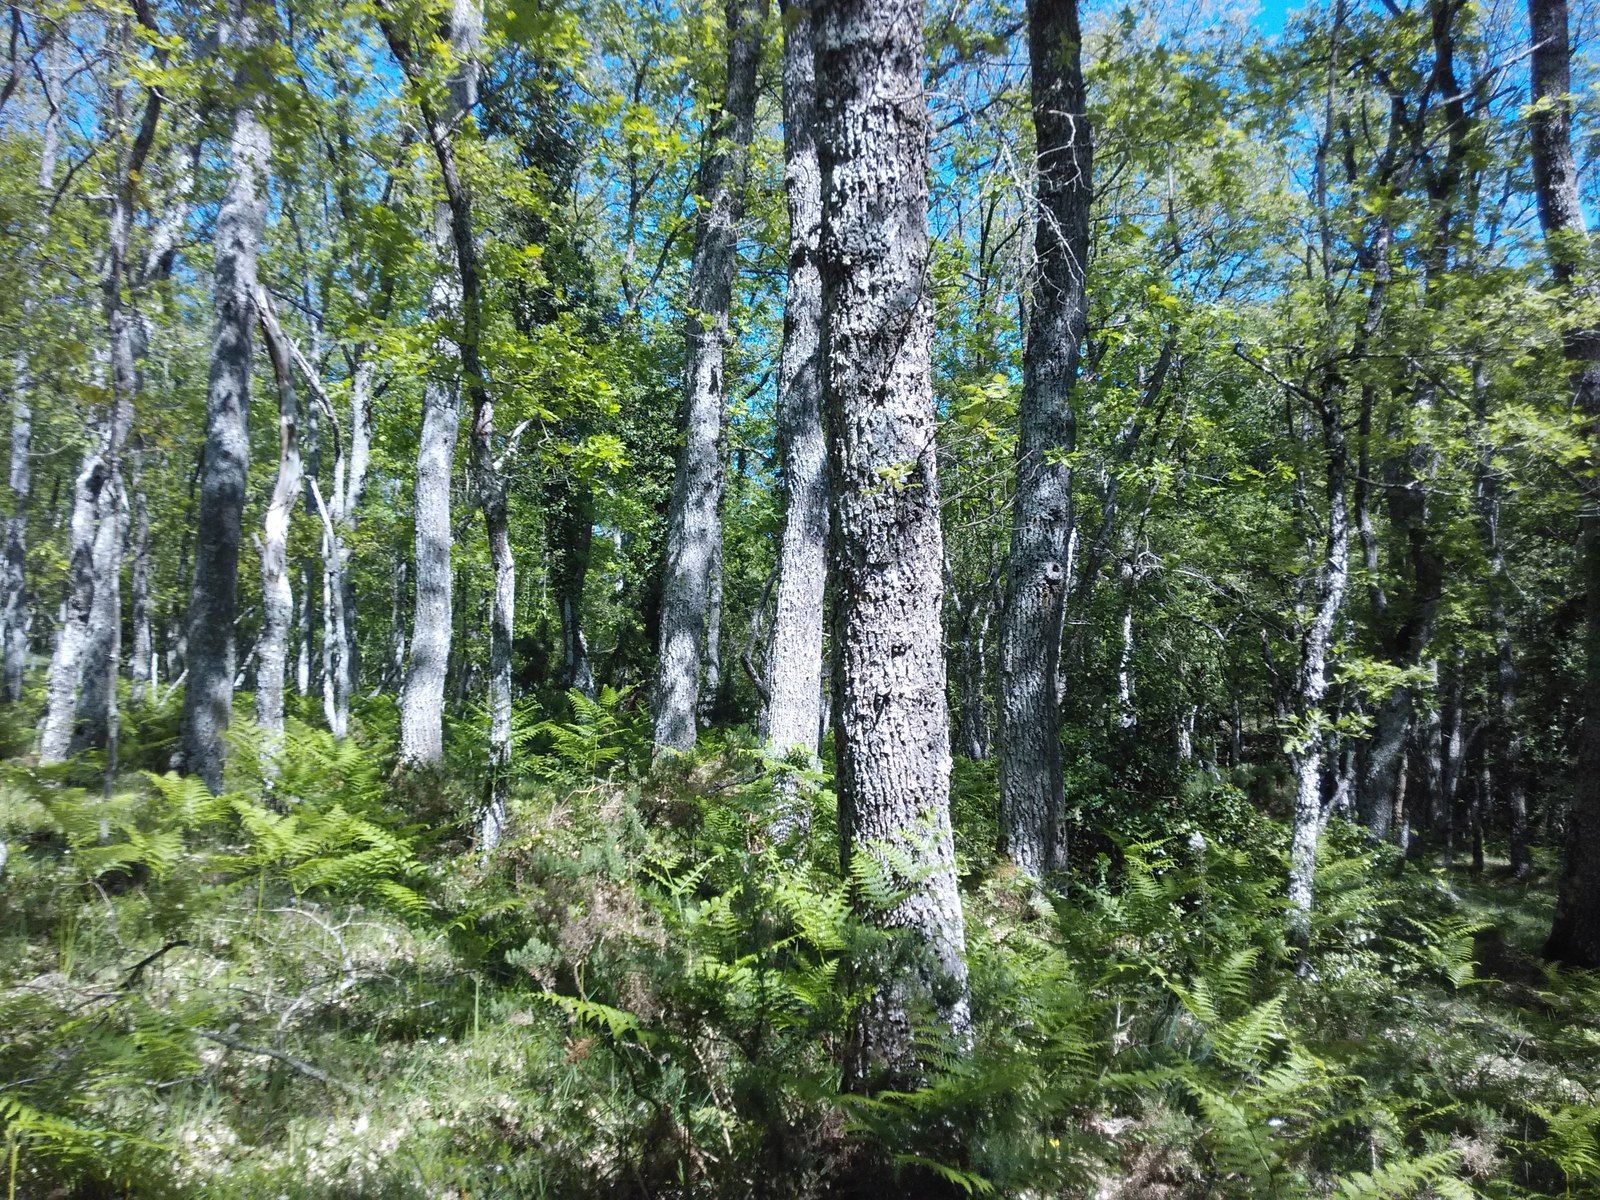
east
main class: Woodland
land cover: Broadleaved woodland
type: acidophilous oak and oak-birch forest
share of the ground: > 75 %
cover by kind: broadleaved forest trees 75 %, shrubs 15 %, herbaceous plants 10 %
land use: Forestry
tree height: > 5 m
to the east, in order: Broadleaved woodland
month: May
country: ES
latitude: 42.6637
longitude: -2.4793
